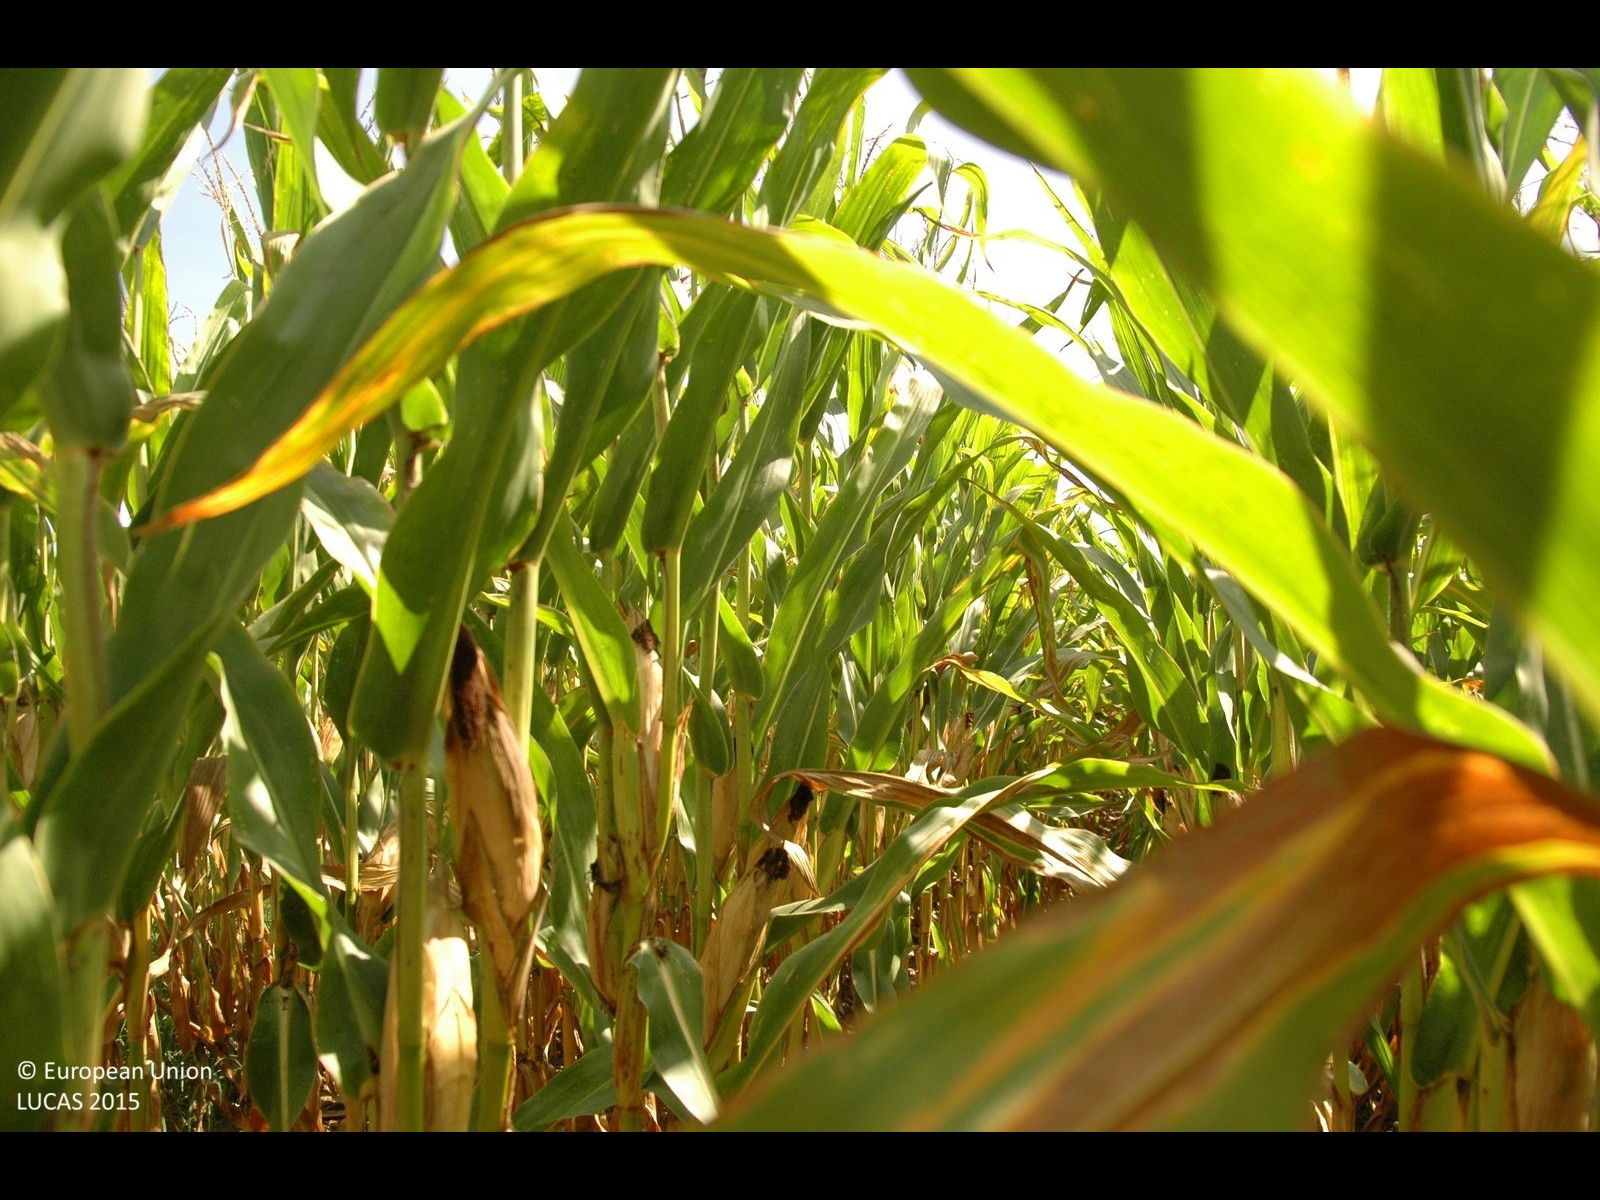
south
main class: Cropland
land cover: Maize
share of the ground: > 75 %
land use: Agriculture (excluding fallow land and kitchen gardens)
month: August
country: HR
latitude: 46.2734
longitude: 16.8923
